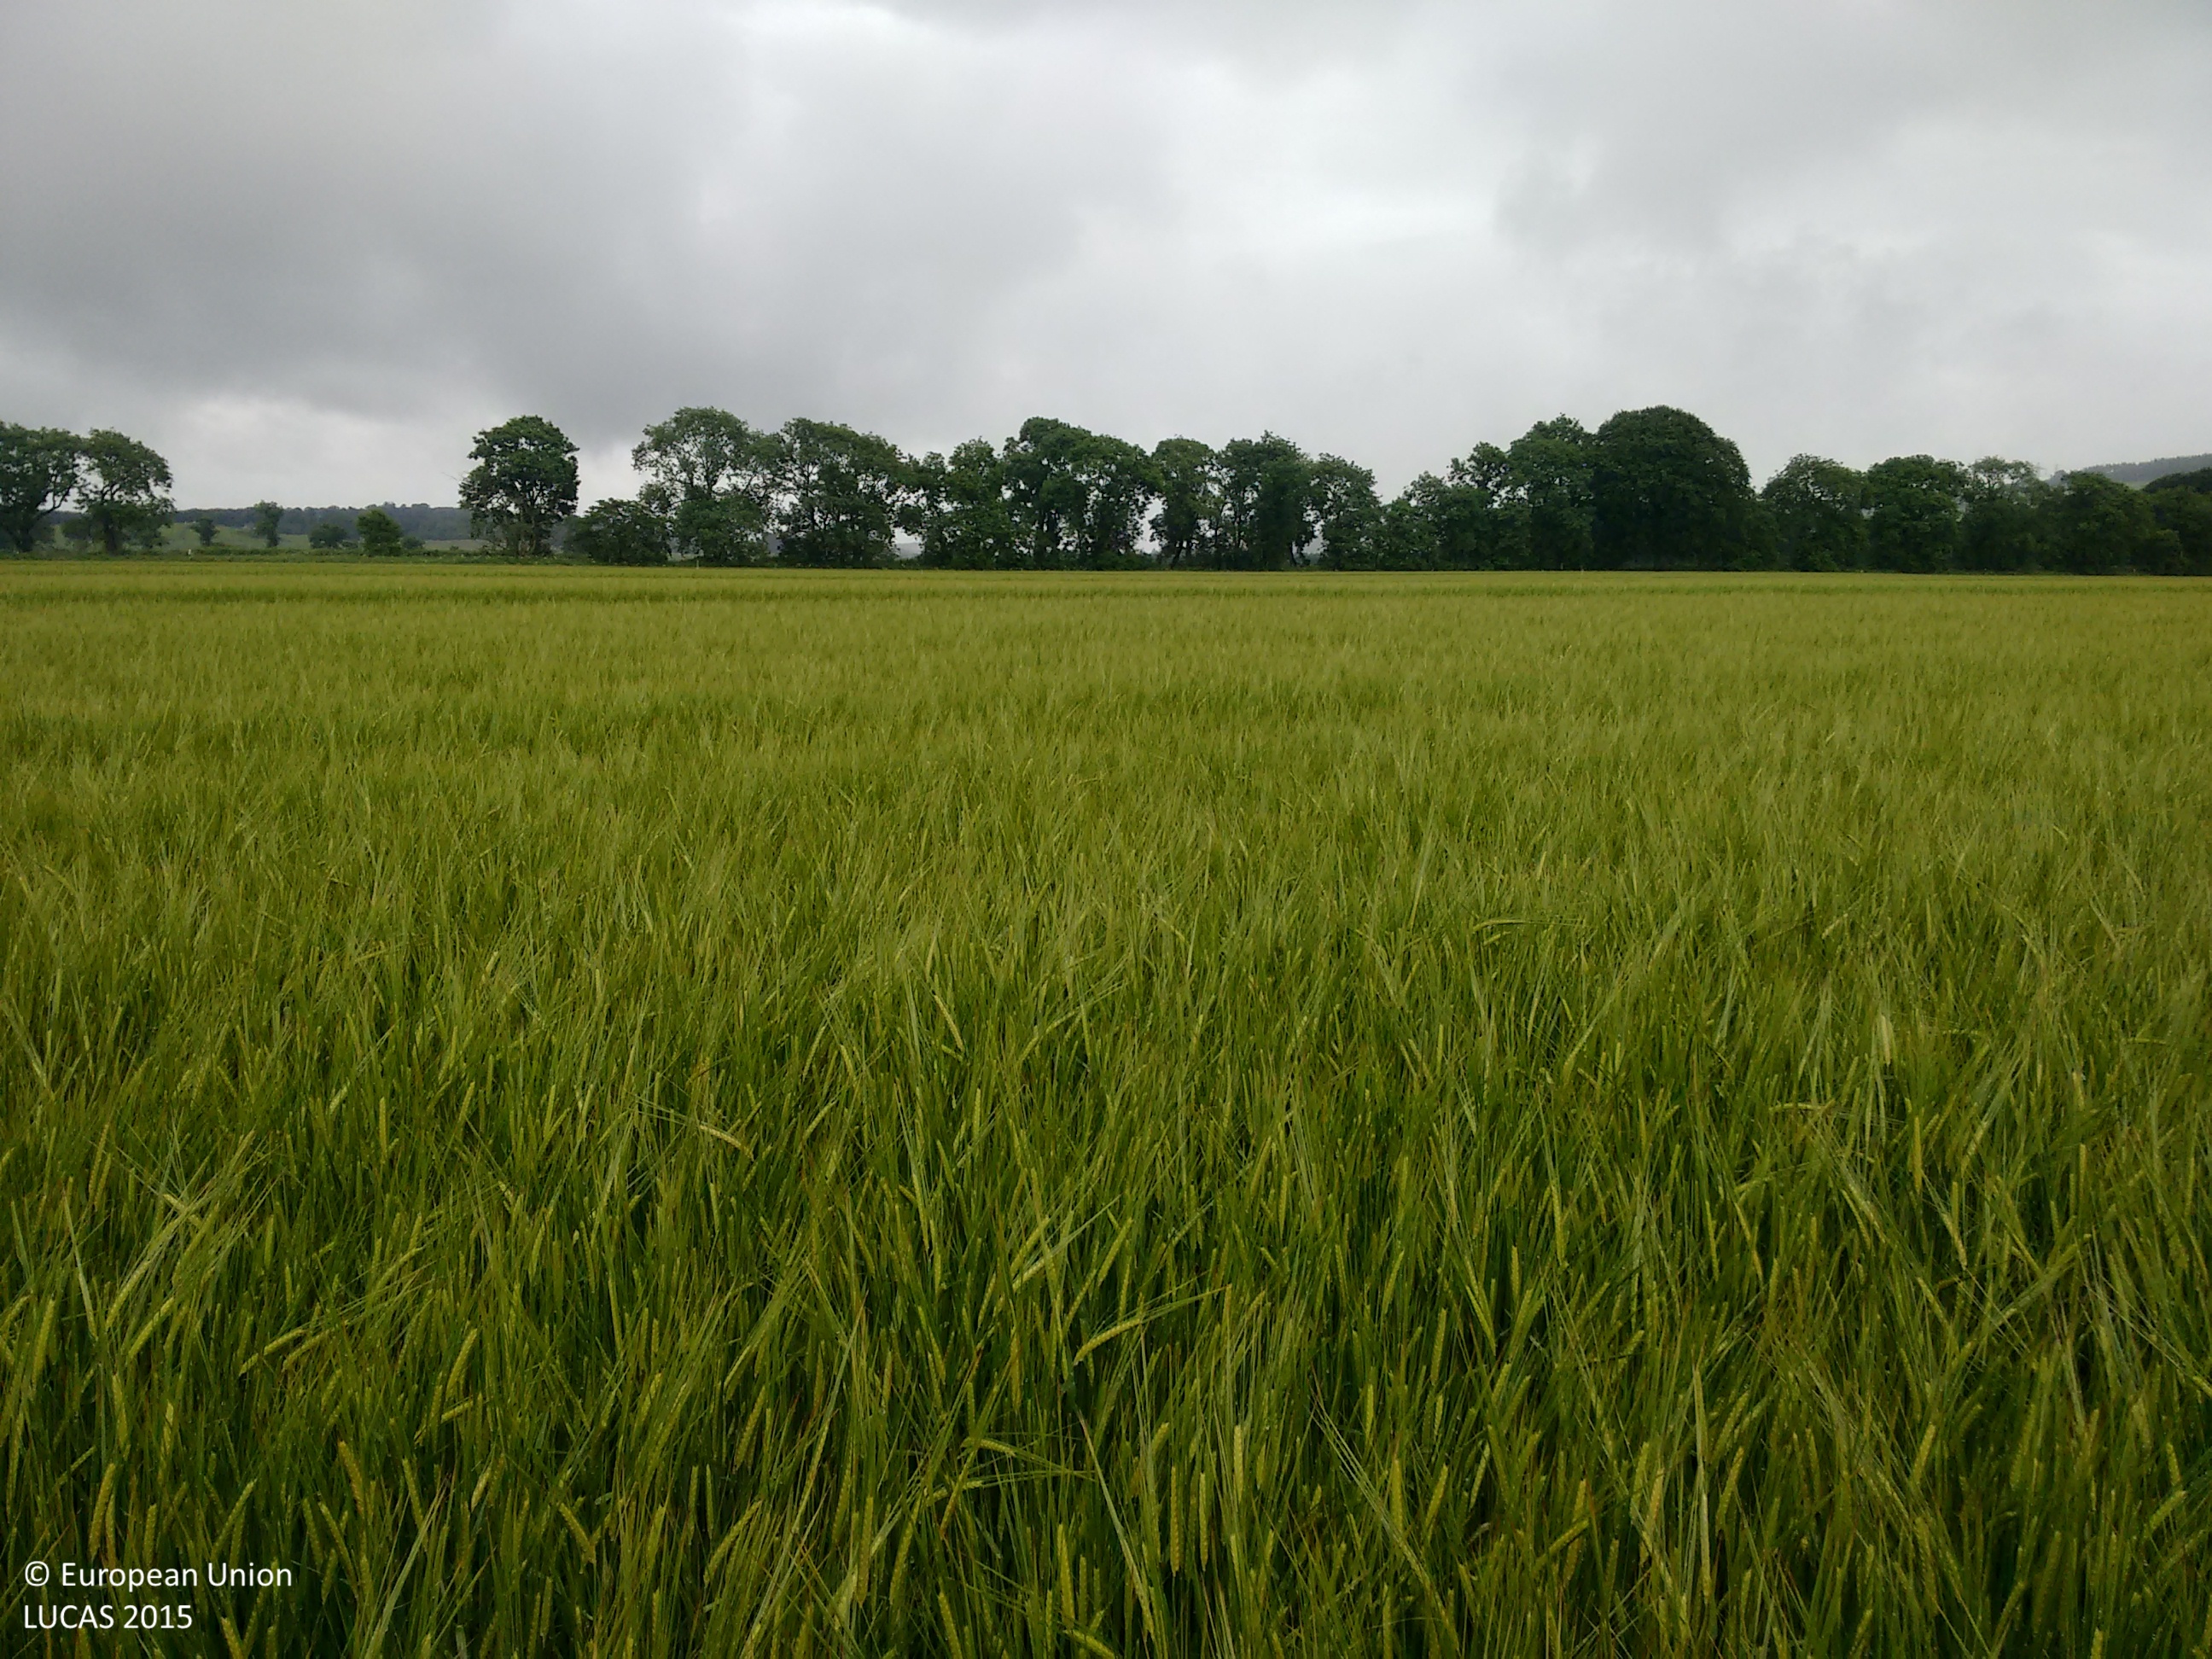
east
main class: Cropland
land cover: Barley
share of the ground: > 75 %
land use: Agriculture (excluding fallow land and kitchen gardens)
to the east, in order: Barley; Spontaneously vegetated surfaces; Fences; Broadleaved woodland; Rivers and streams; Broadleaved woodland; Fences; Spontaneously vegetated surfaces; Grassland without tree/shrub cover
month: July
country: GB
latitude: 57.2333
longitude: -2.2934
